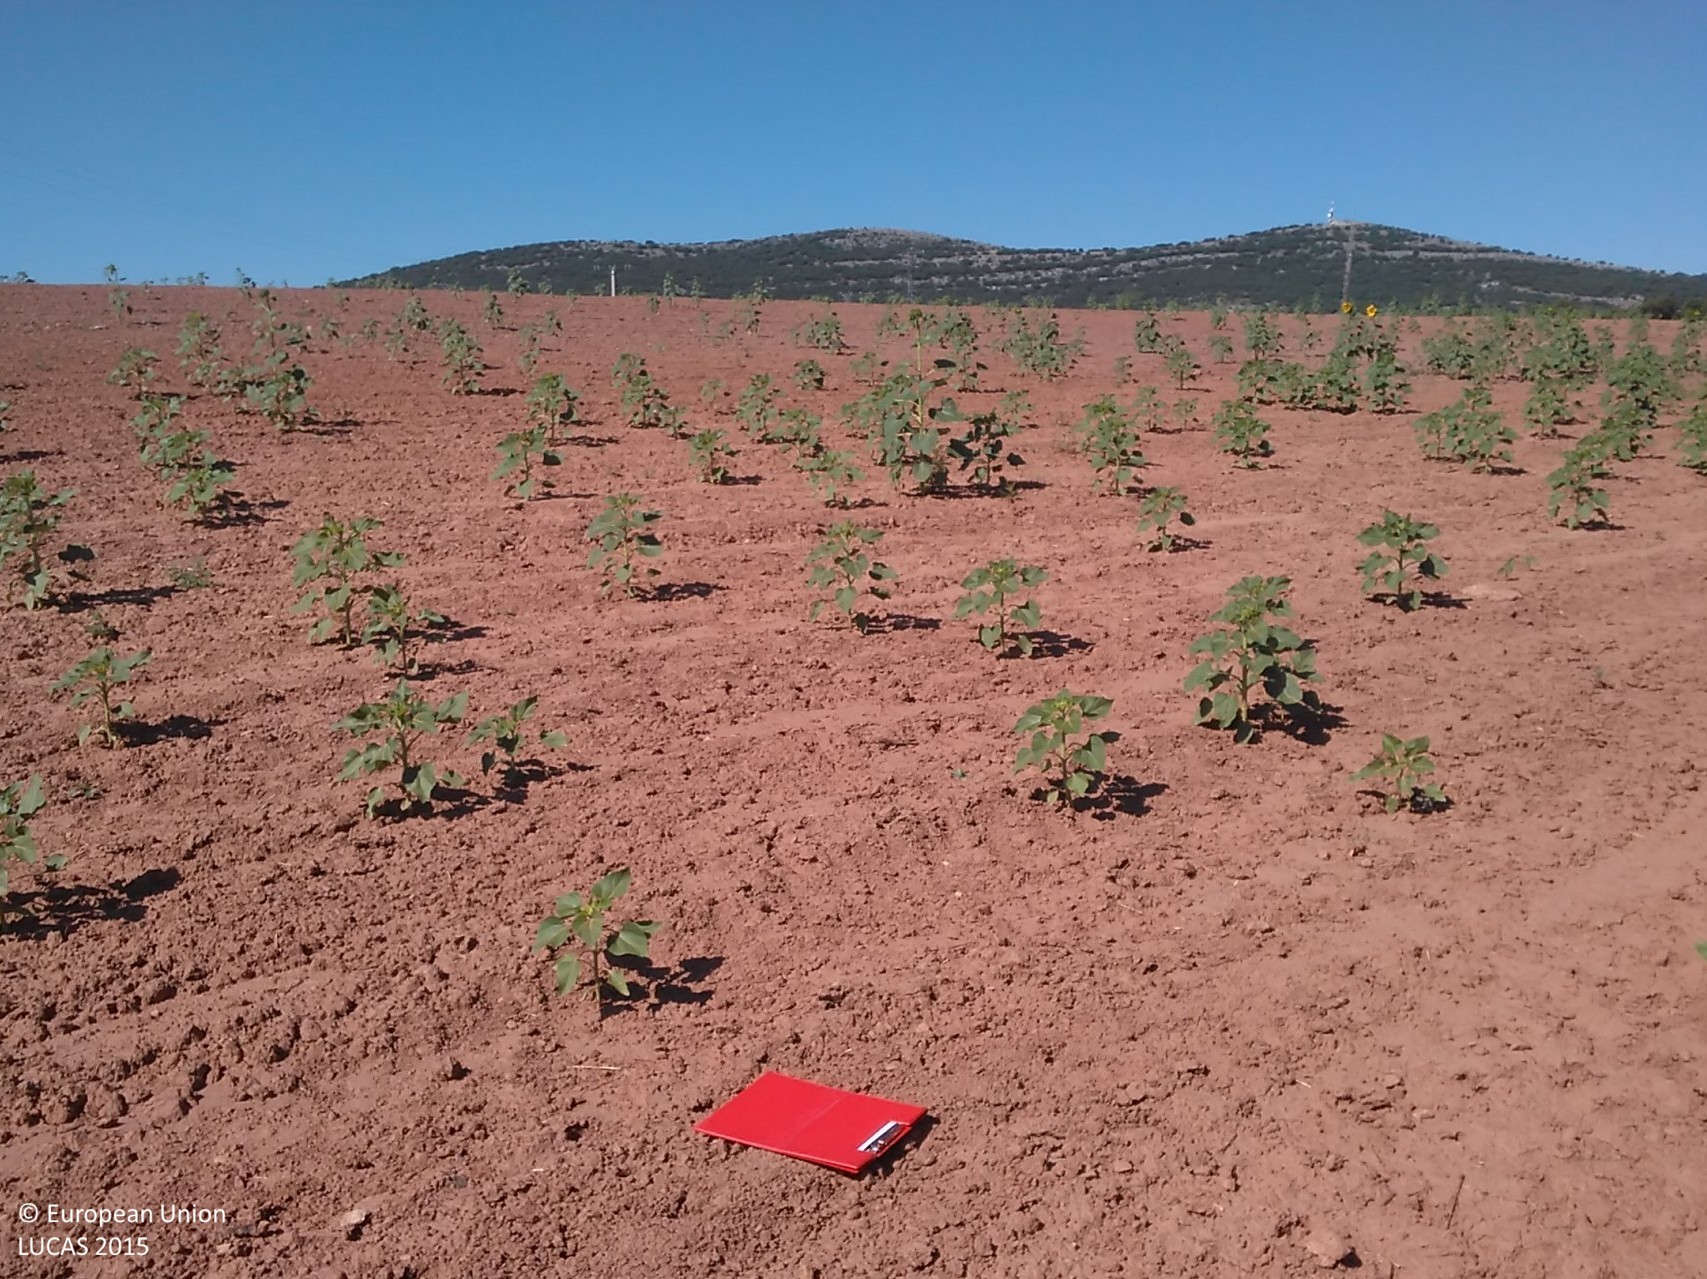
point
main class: Cropland
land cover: Sunflower
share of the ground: 10 - 25 %
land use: Agriculture (excluding fallow land and kitchen gardens)
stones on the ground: < 10 %
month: July
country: ES
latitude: 41.5153
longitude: -2.0249
